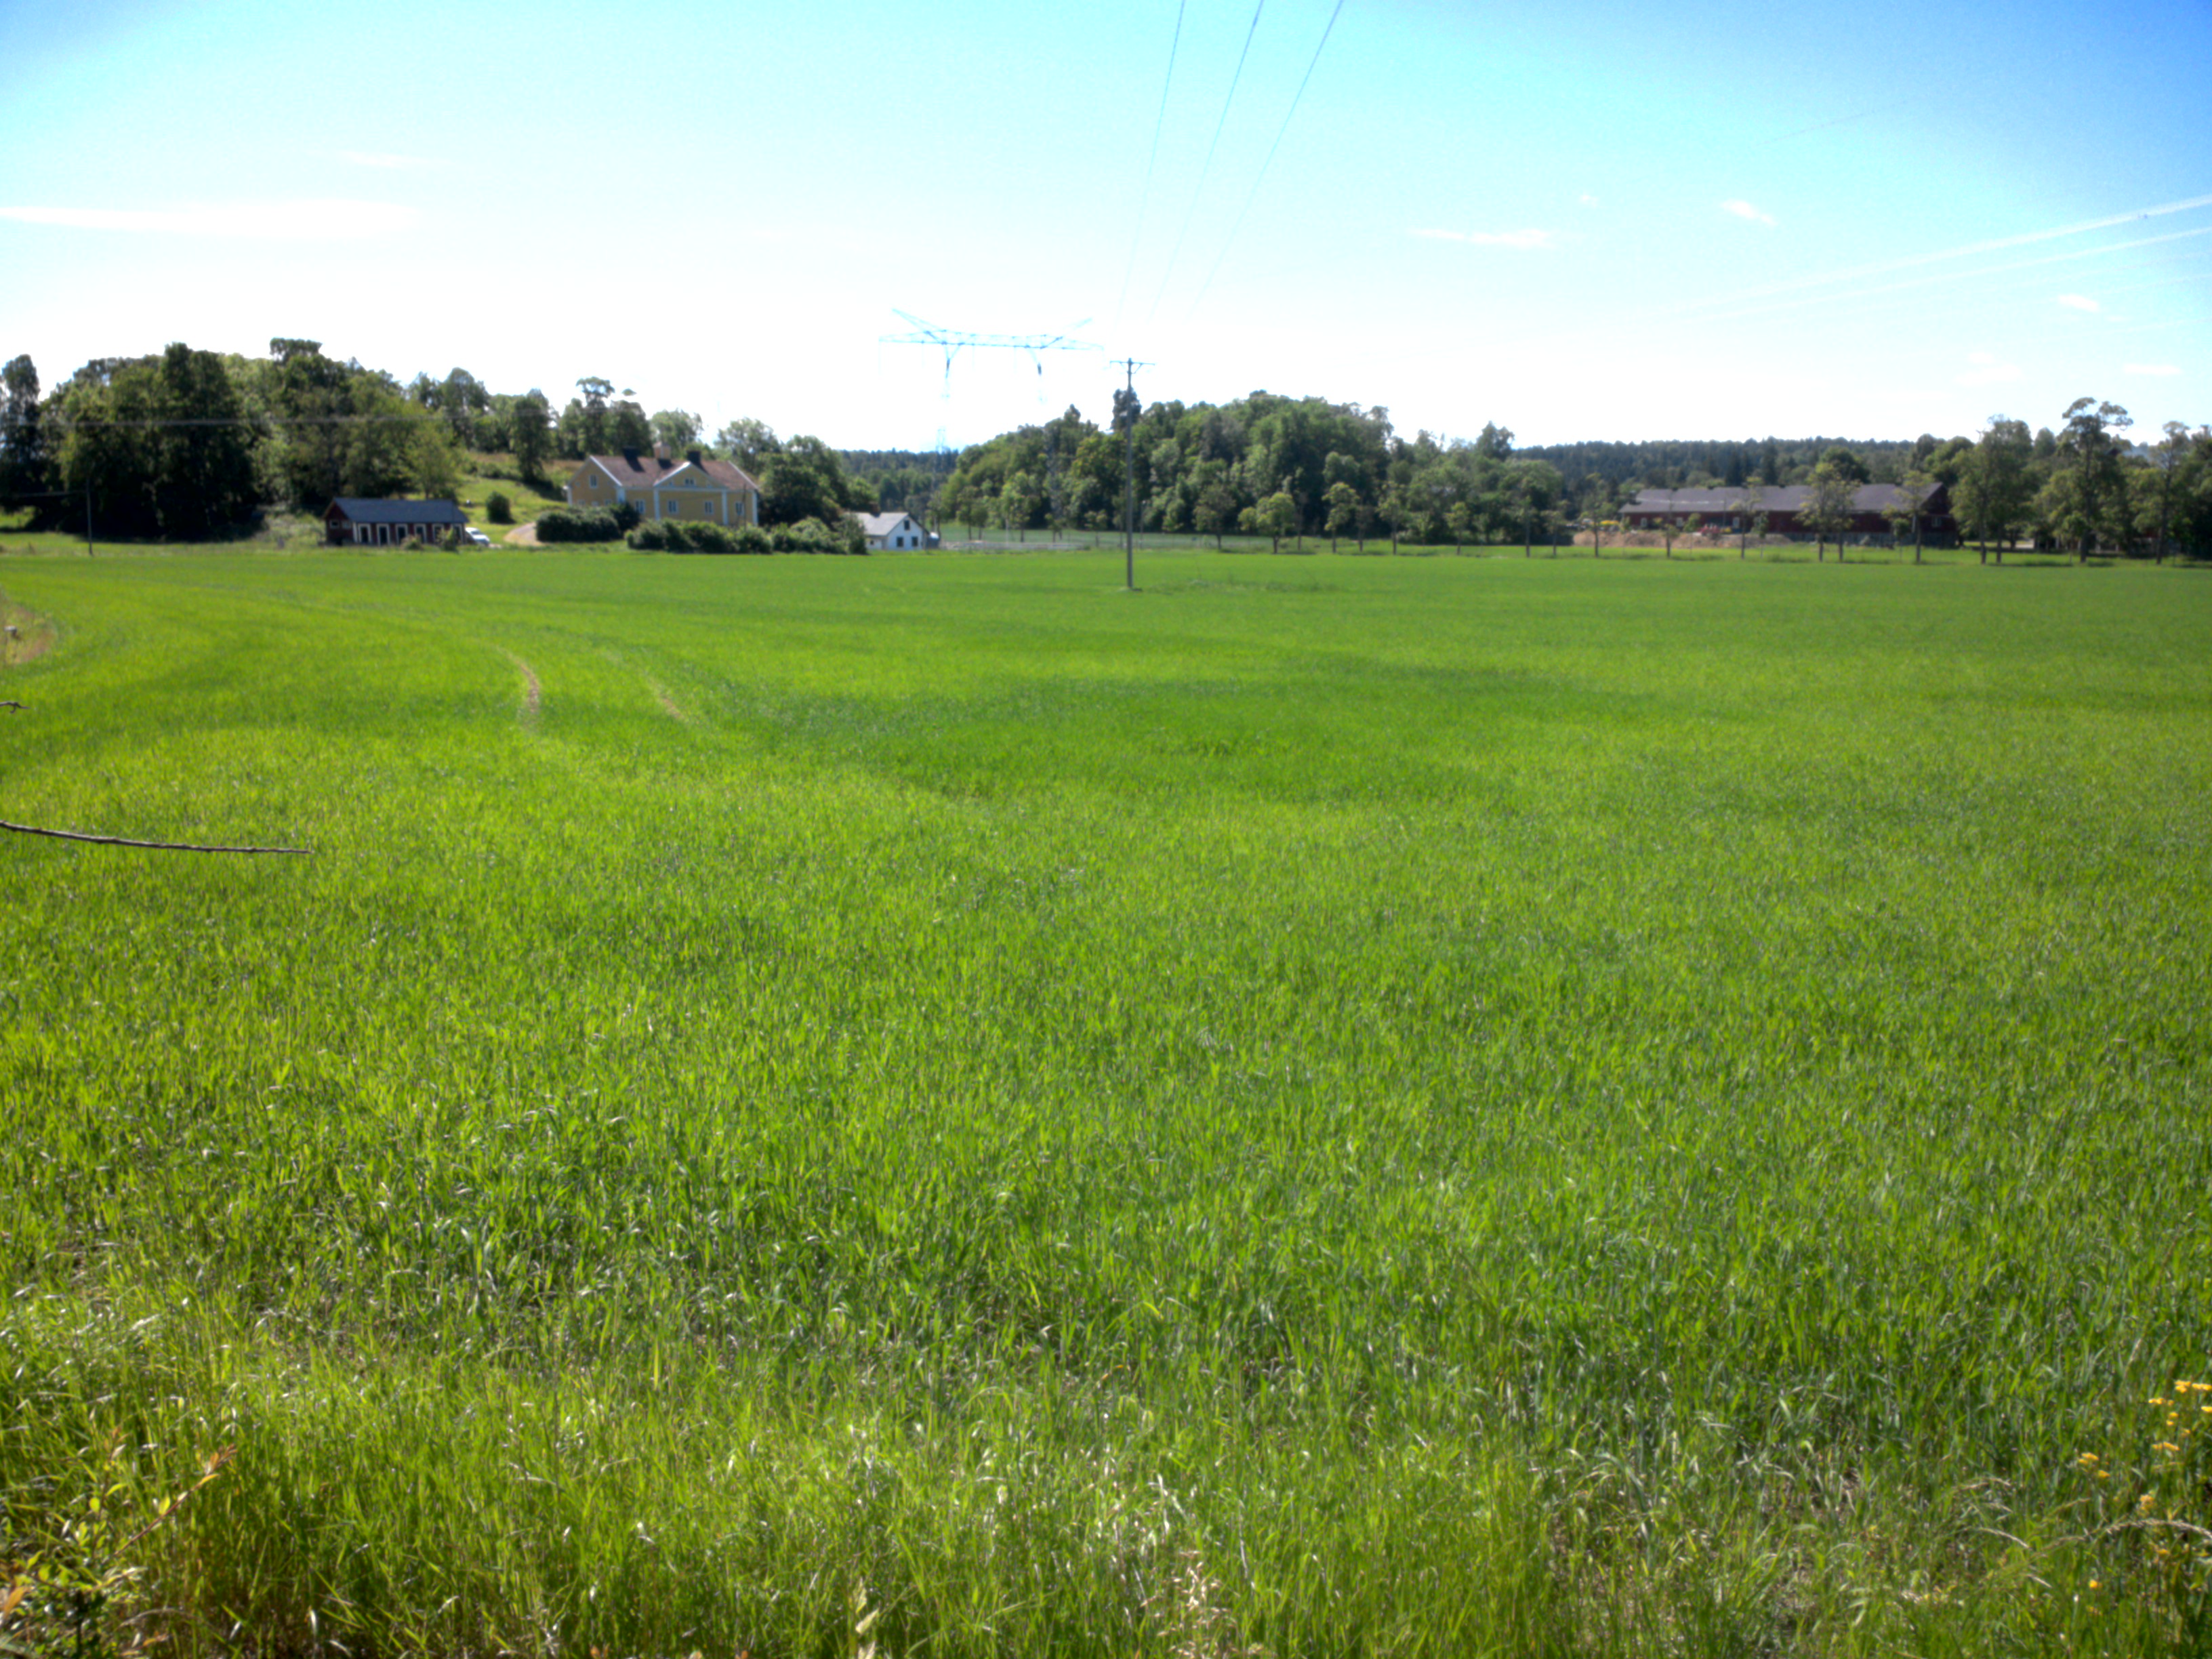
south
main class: Shrubland
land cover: Shrubland with sparse tree cover
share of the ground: > 75 %
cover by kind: shrubs 90 %, broadleaved forest trees 5 %, herbaceous plants 5 %
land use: Semi-natural and natural areas not in use
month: June
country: SE
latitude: 59.2844
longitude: 17.6675
